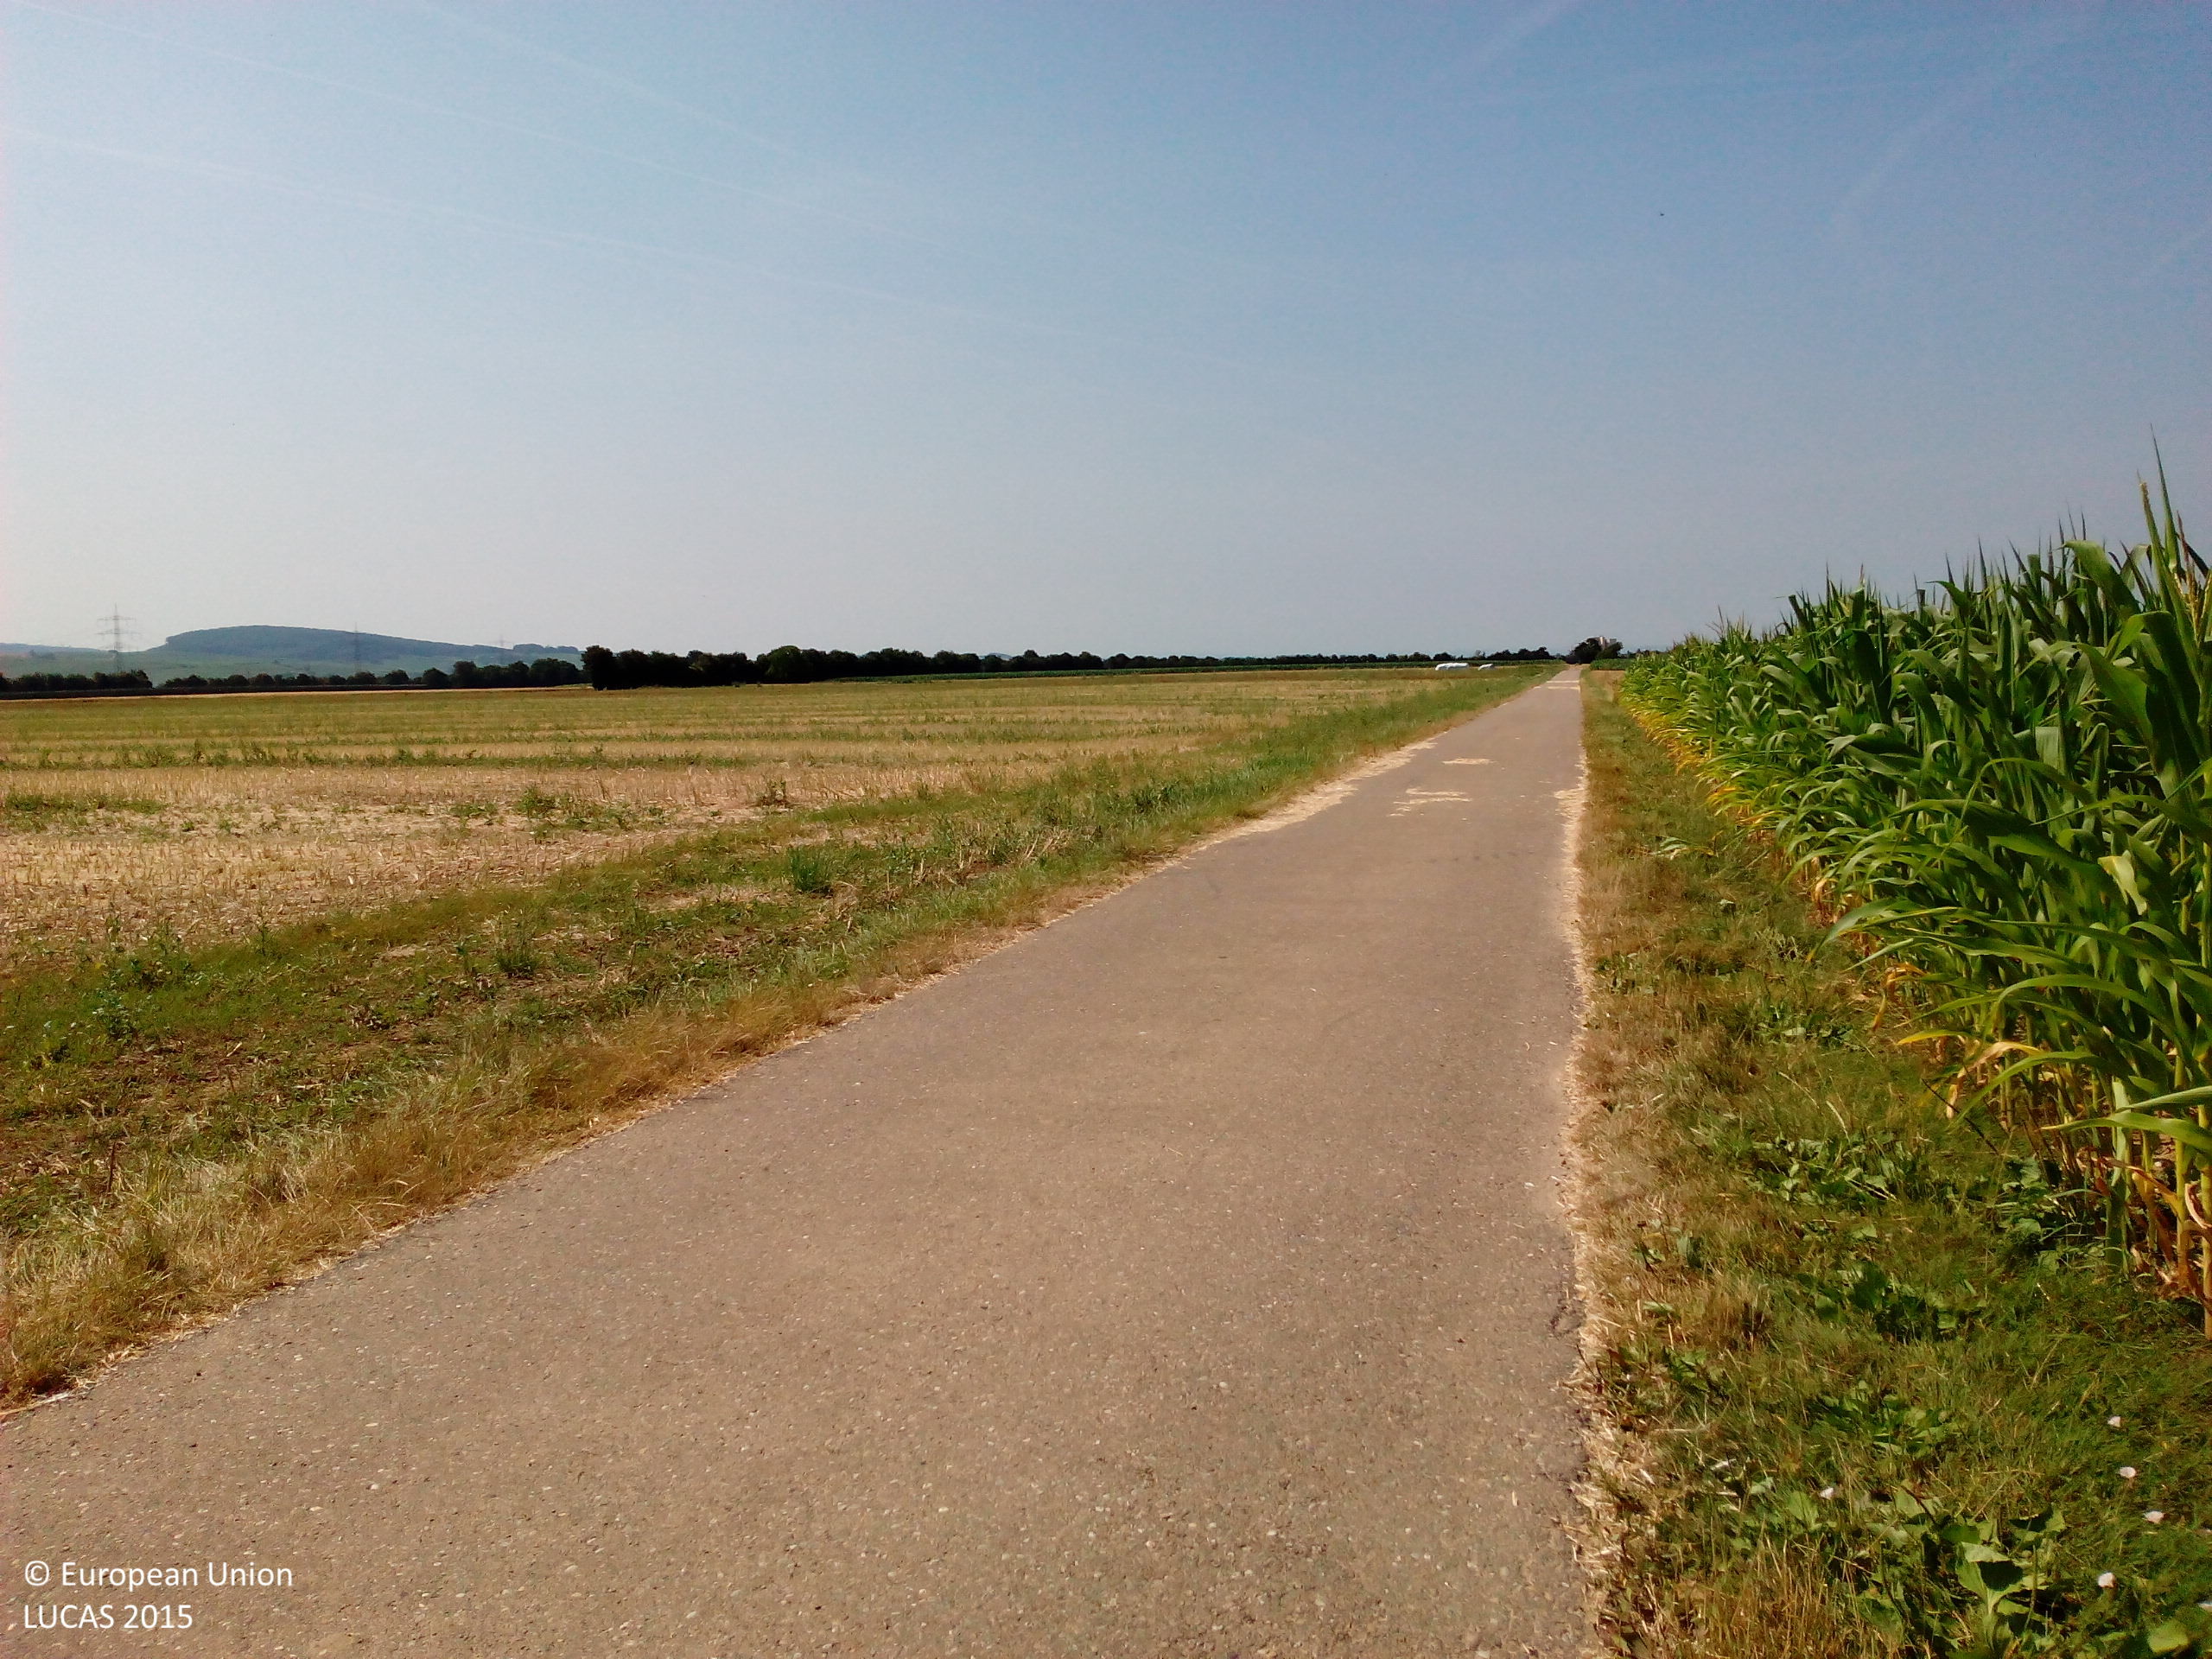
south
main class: Cropland
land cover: Maize
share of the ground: > 75 %
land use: Agriculture (excluding fallow land and kitchen gardens)
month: July
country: DE
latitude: 47.8370
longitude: 7.5831
